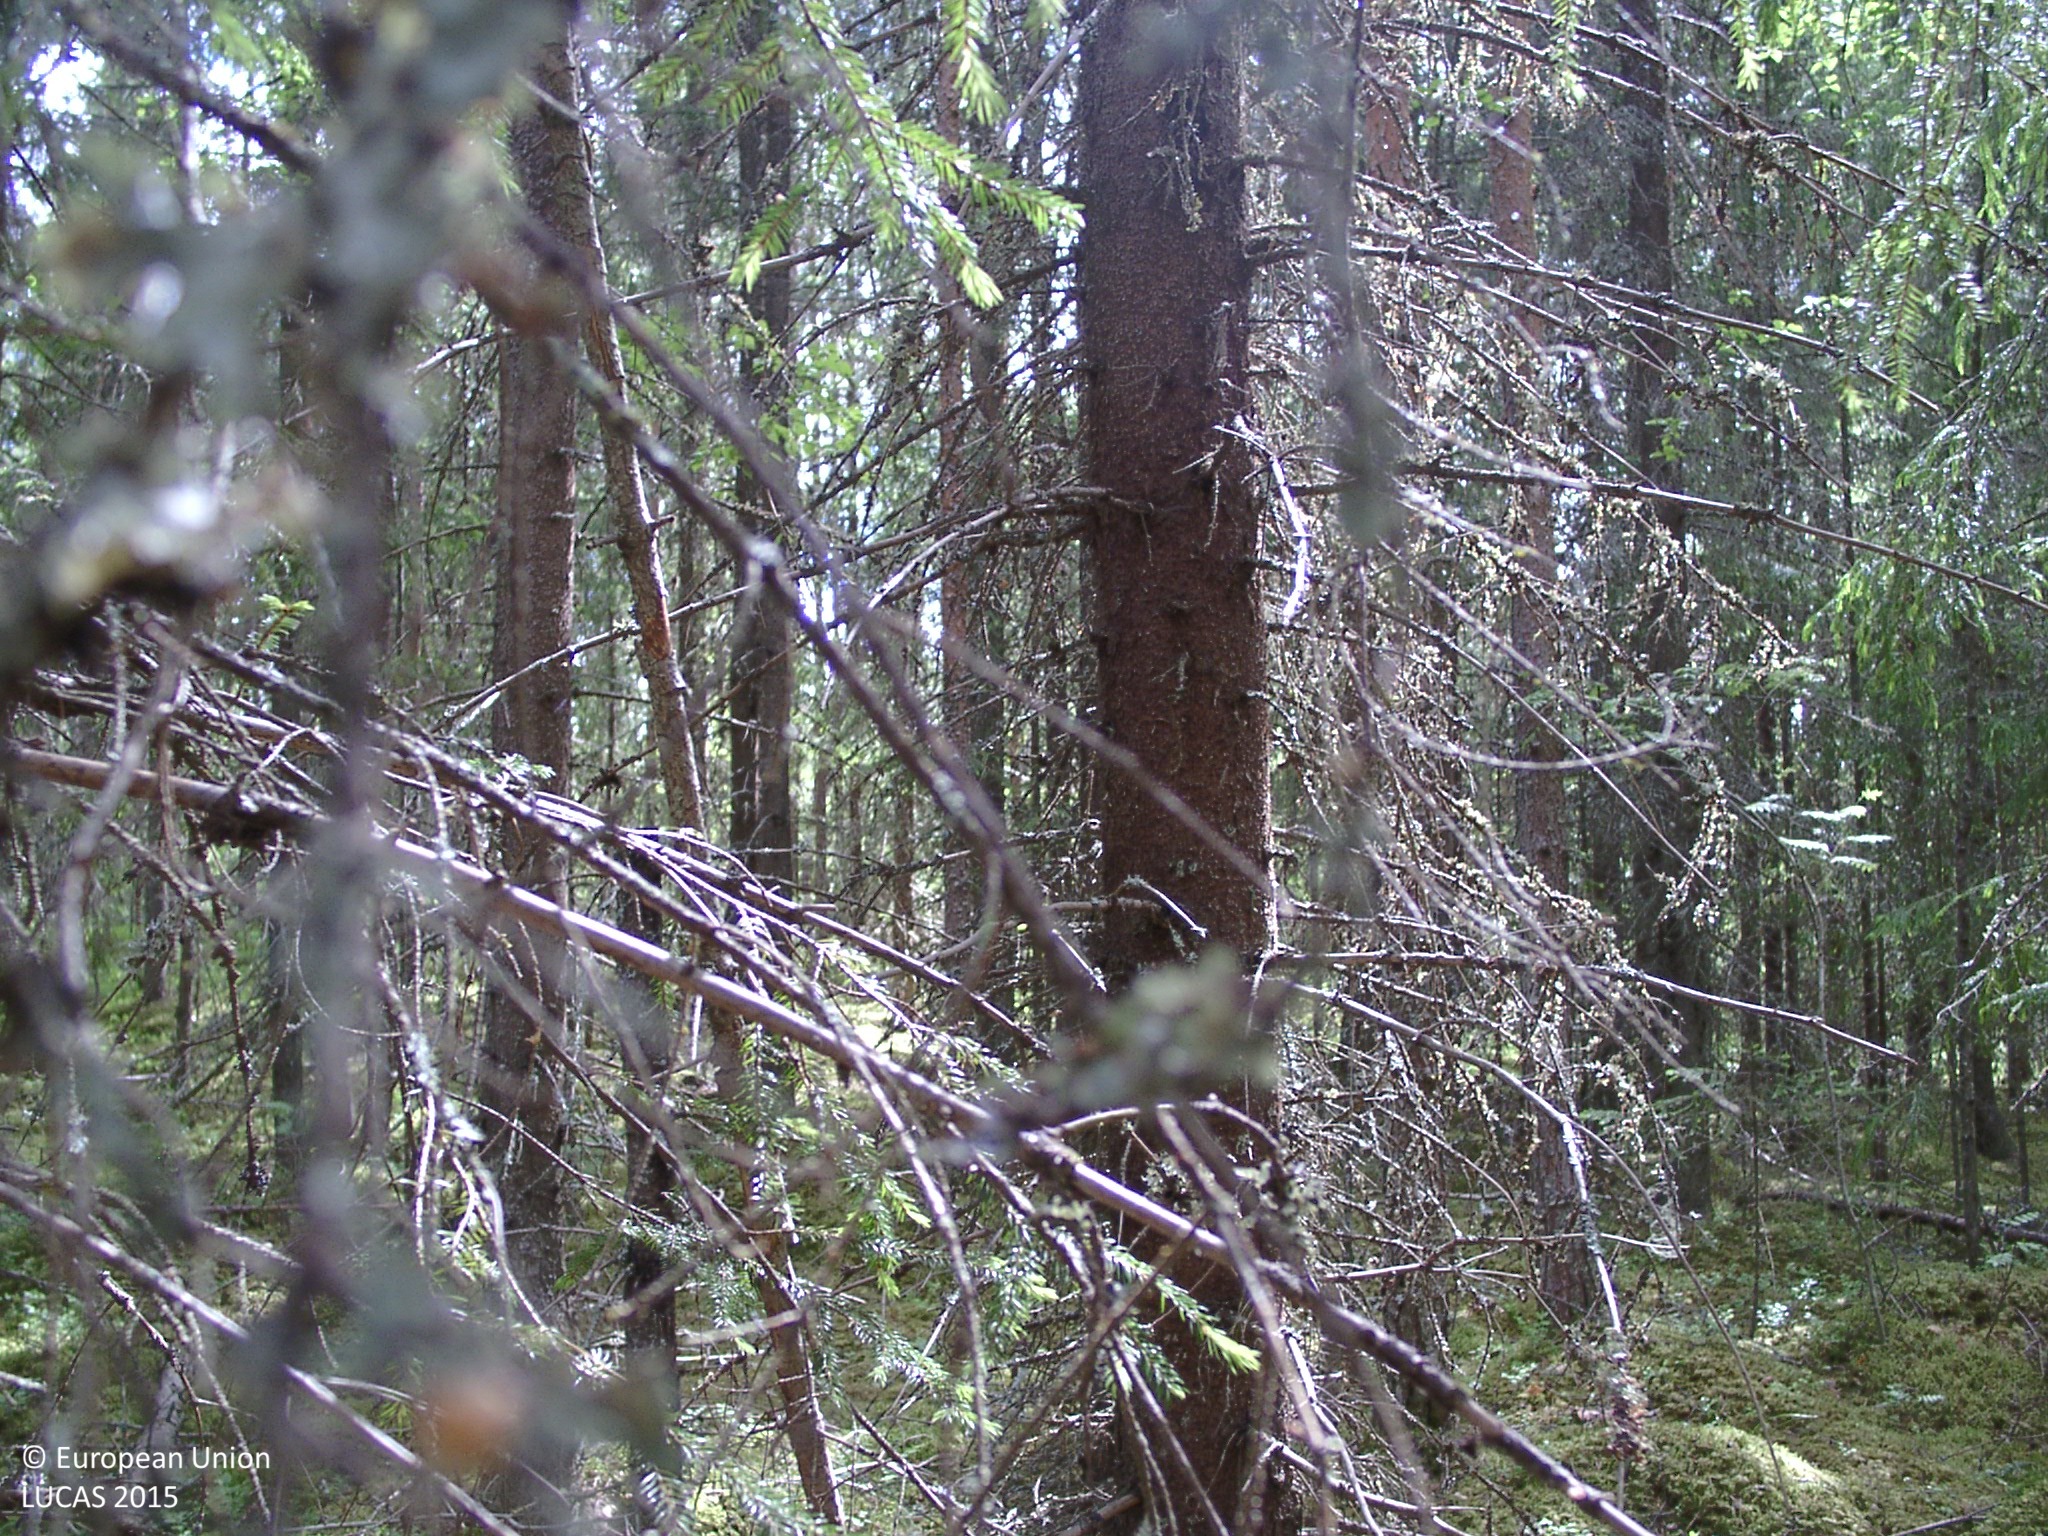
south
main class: Woodland
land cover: Spruce dominated coniferous woodland
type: boreal forest
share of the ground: > 75 %
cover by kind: coniferous forest trees 75 %, lichens and mosses 20 %, shrubs 5 %
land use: Semi-natural and natural areas not in use
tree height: > 5 m
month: June
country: FI
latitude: 61.8447
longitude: 24.5536
